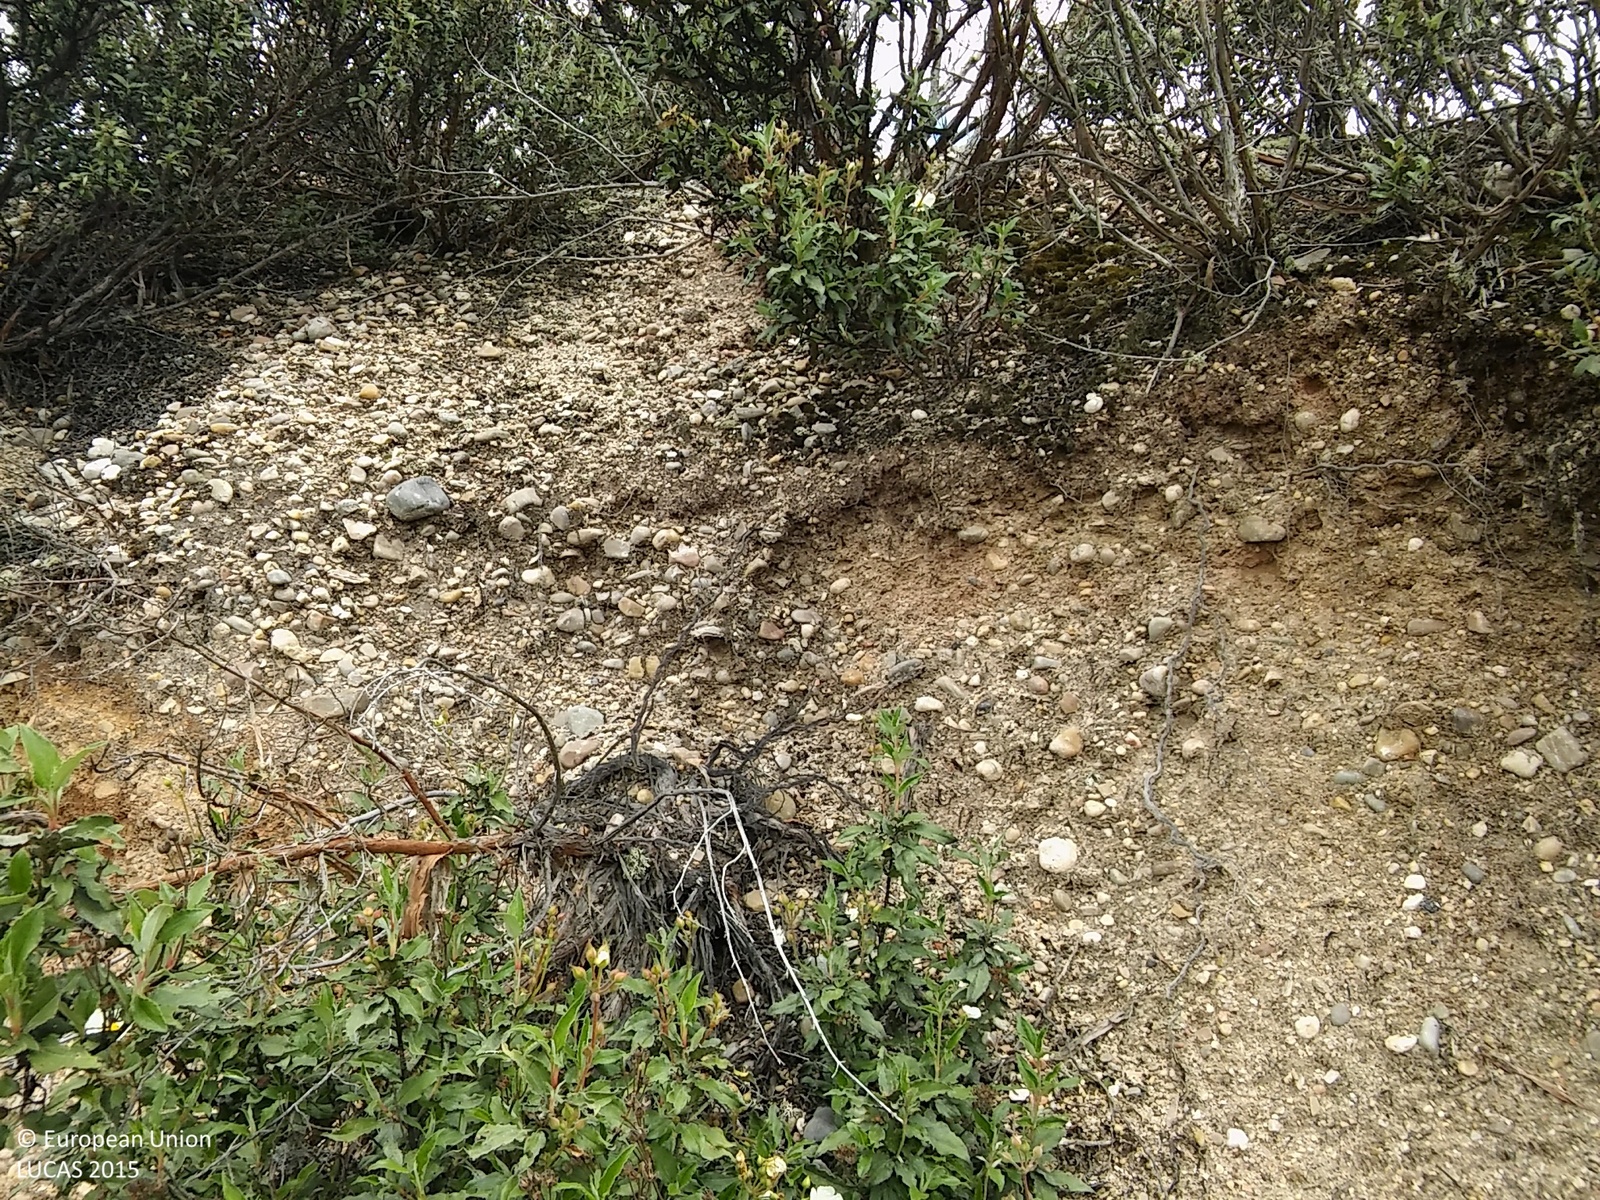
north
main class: Shrubland
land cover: Shrubland with sparse tree cover
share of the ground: 50 - 75 %
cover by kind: shrubs 50 %, unconsolidated bare surface 30 %, herbaceous plants 15 %, coniferous forest trees 5 %
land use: Semi-natural and natural areas not in use
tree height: > 5 m
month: June
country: ES
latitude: 41.4460
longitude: -3.6834
